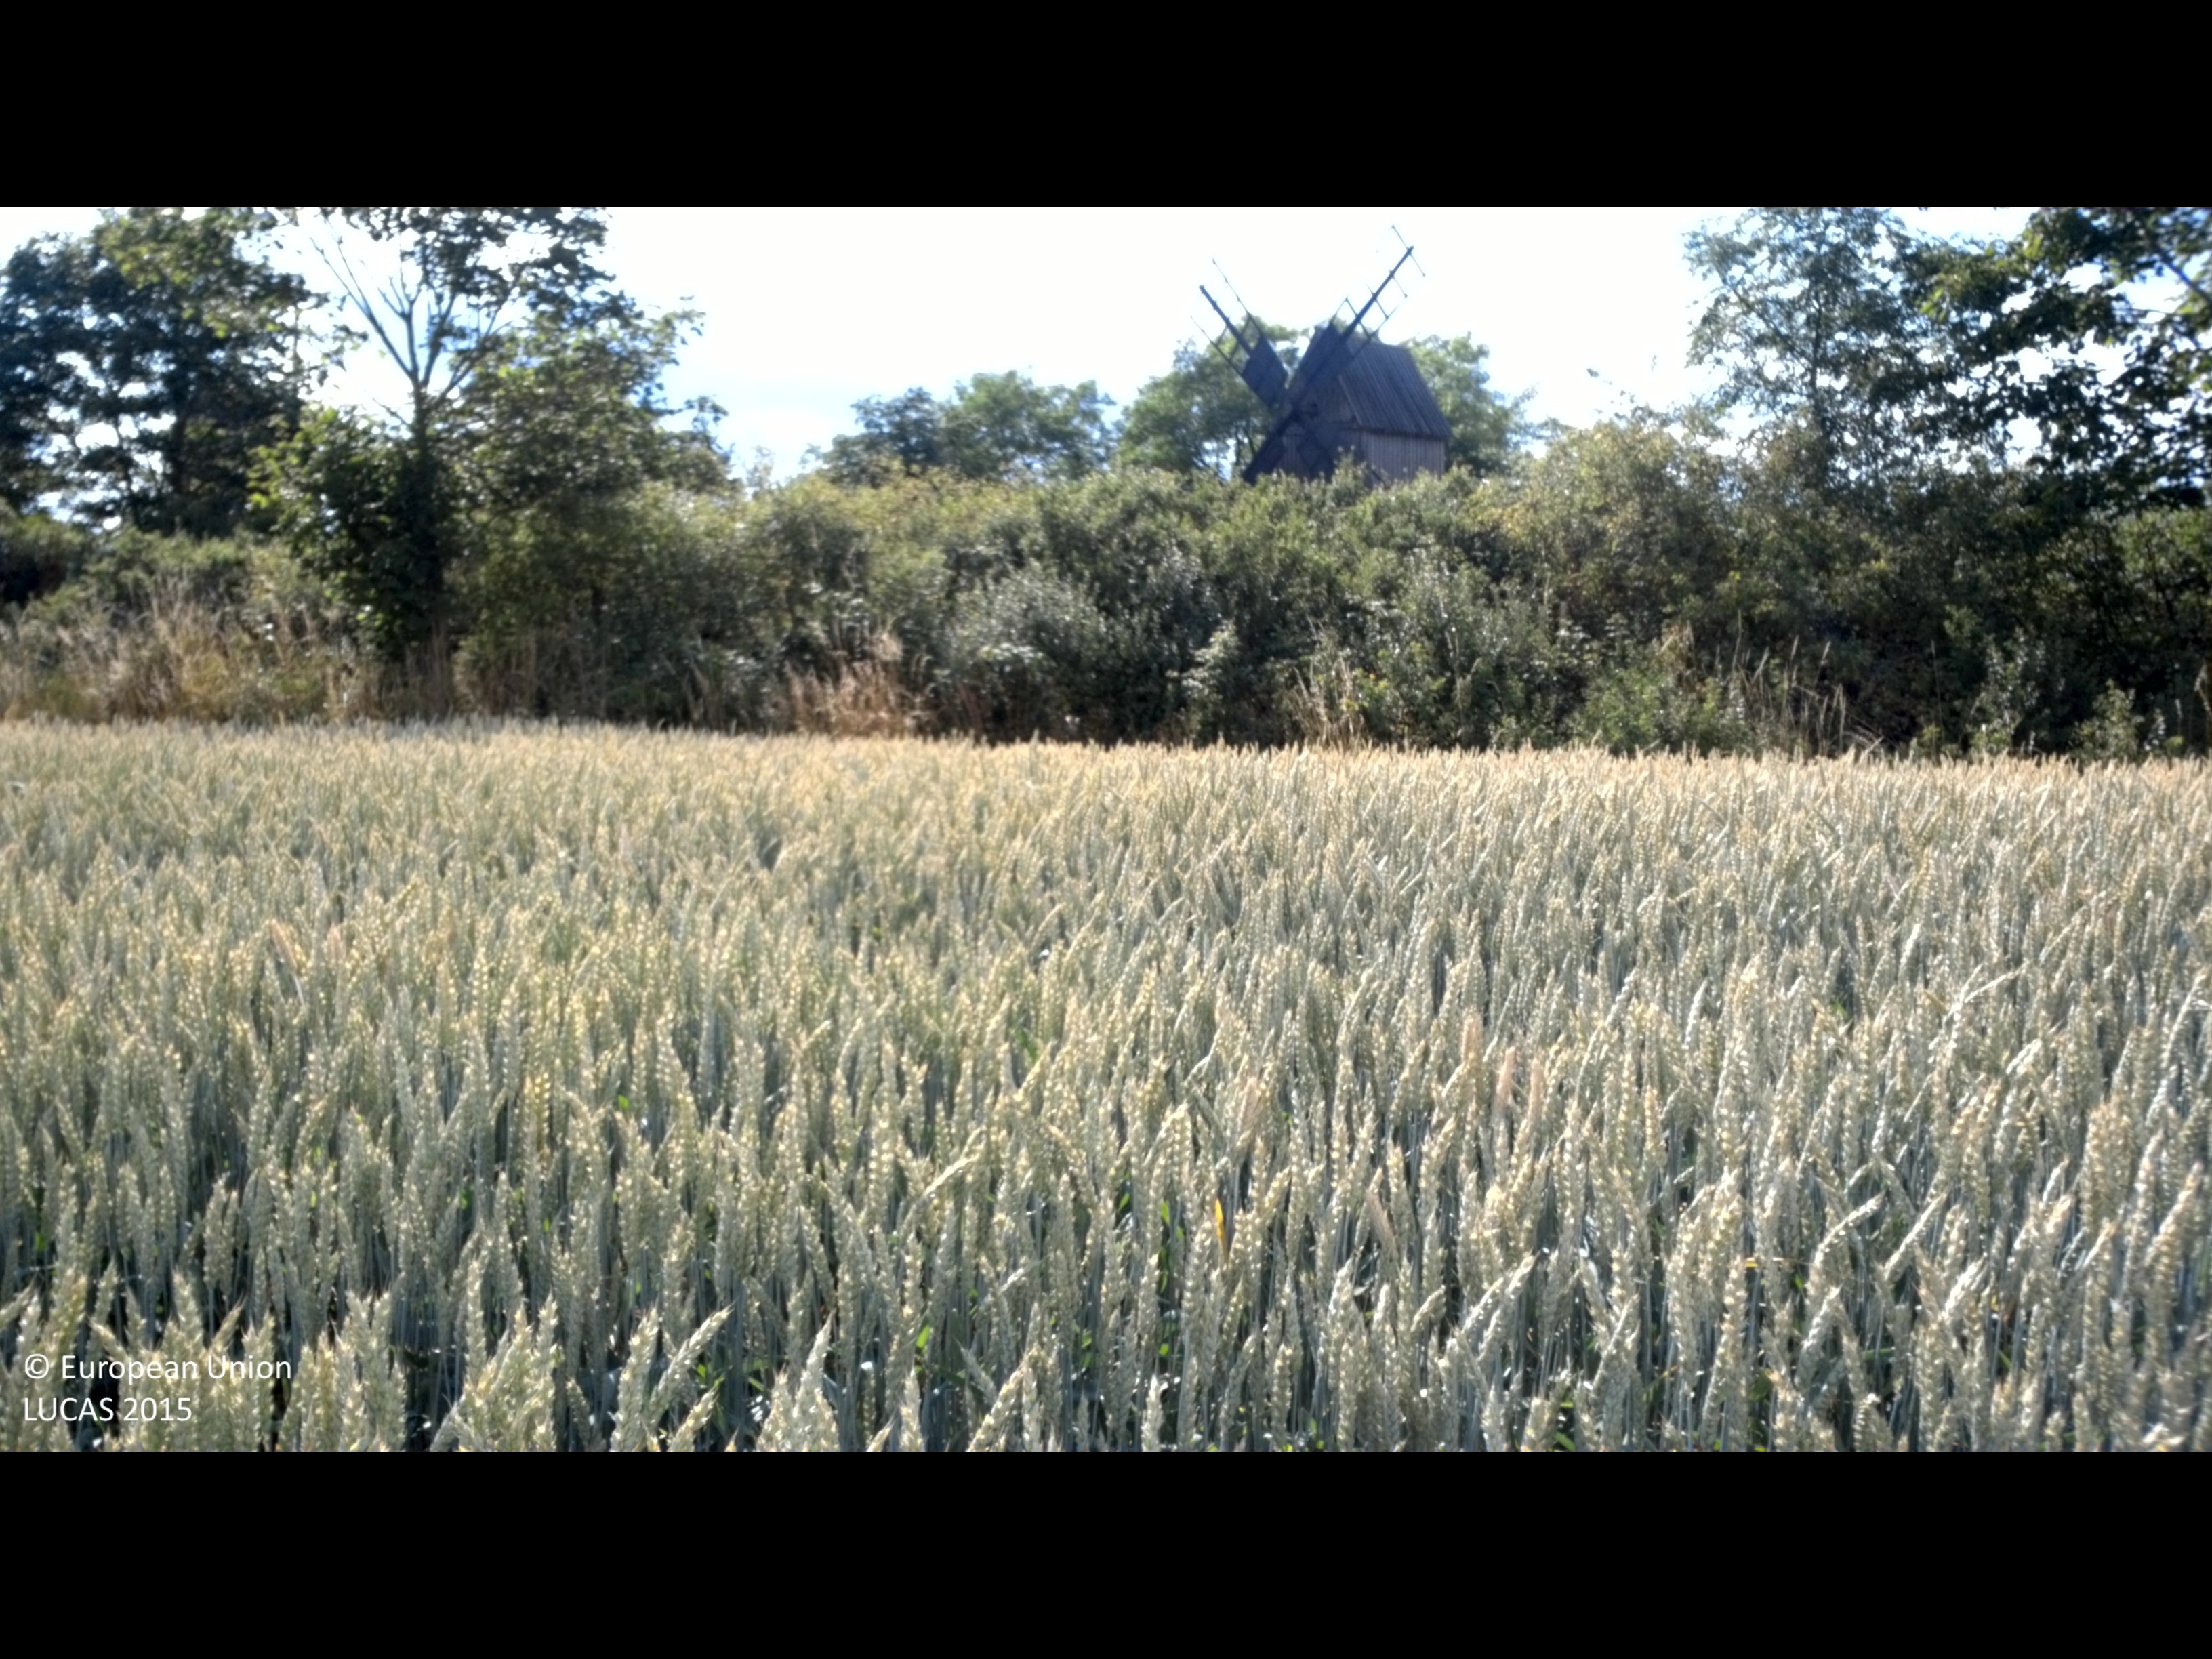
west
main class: Cropland
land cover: Common wheat
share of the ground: > 75 %
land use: Agriculture (excluding fallow land and kitchen gardens)
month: July
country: SE
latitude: 56.5841
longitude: 16.4652
